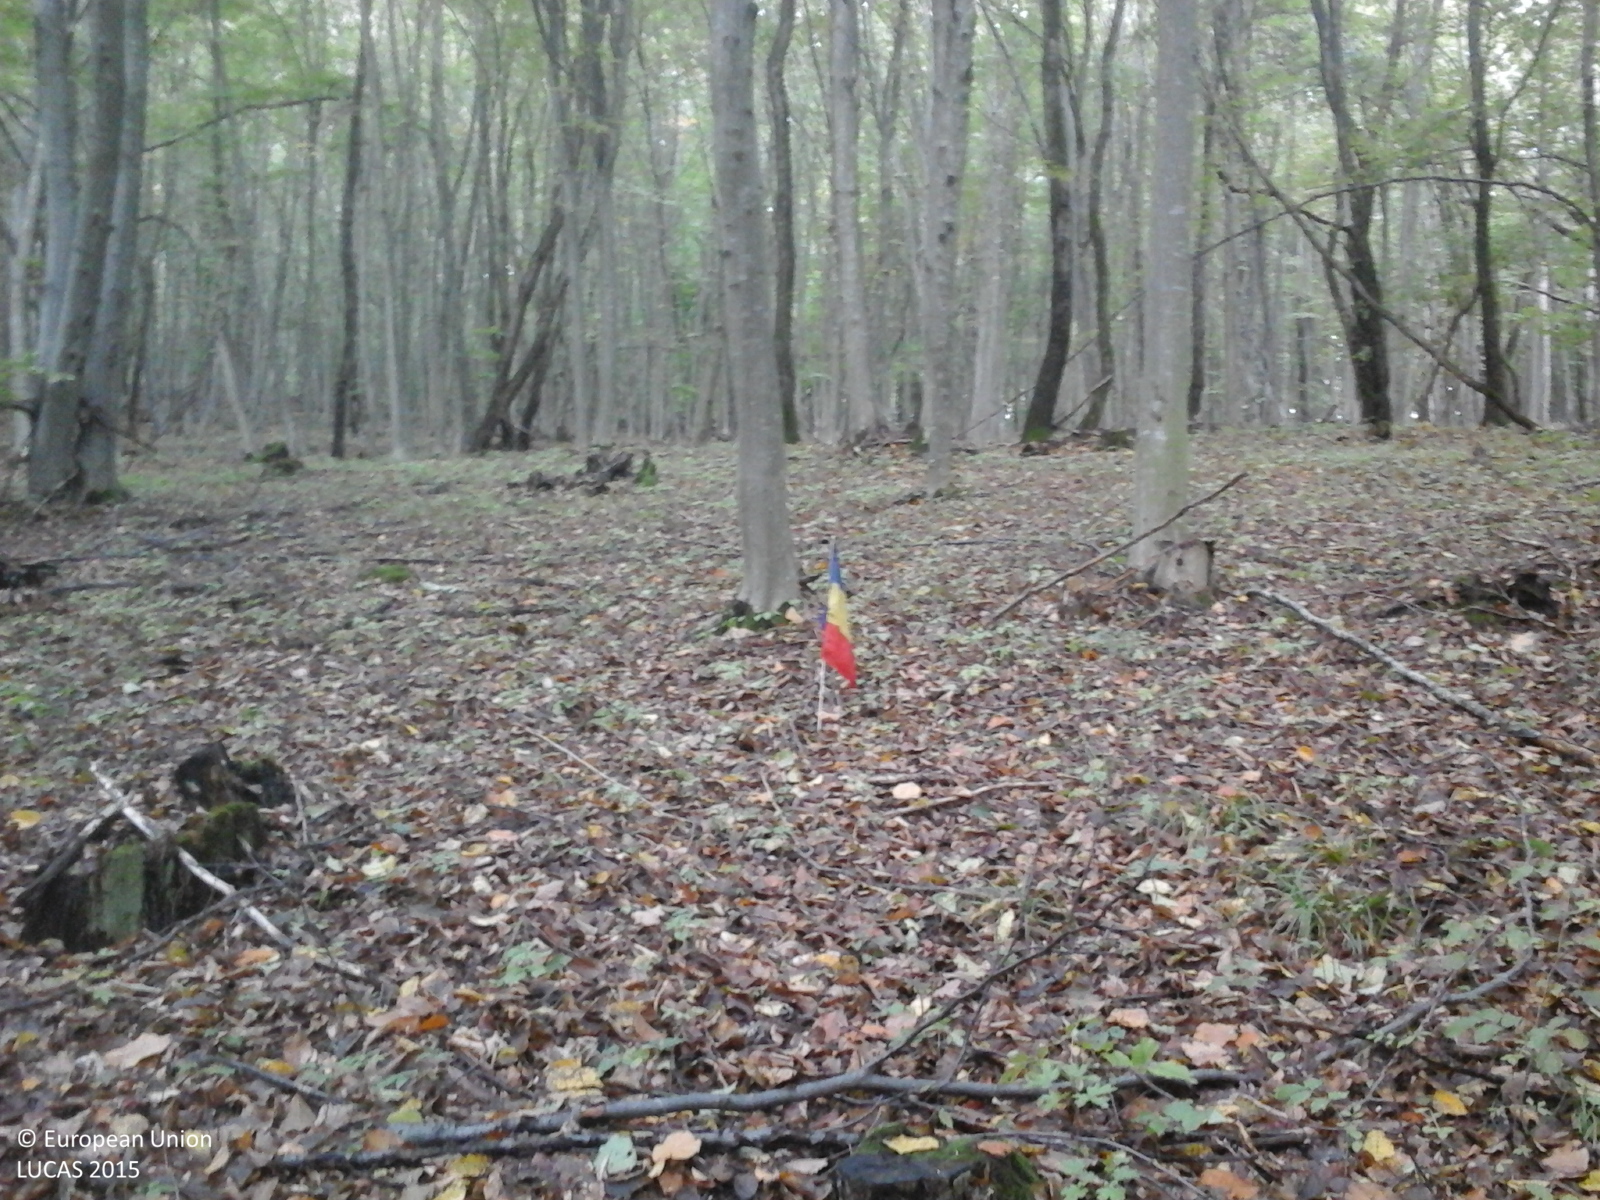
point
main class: Woodland
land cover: Broadleaved woodland
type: beech forest
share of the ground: > 75 %
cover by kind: broadleaved forest trees 100 %
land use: Forestry
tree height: > 5 m
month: October
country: RO
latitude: 45.8964
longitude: 25.0840
